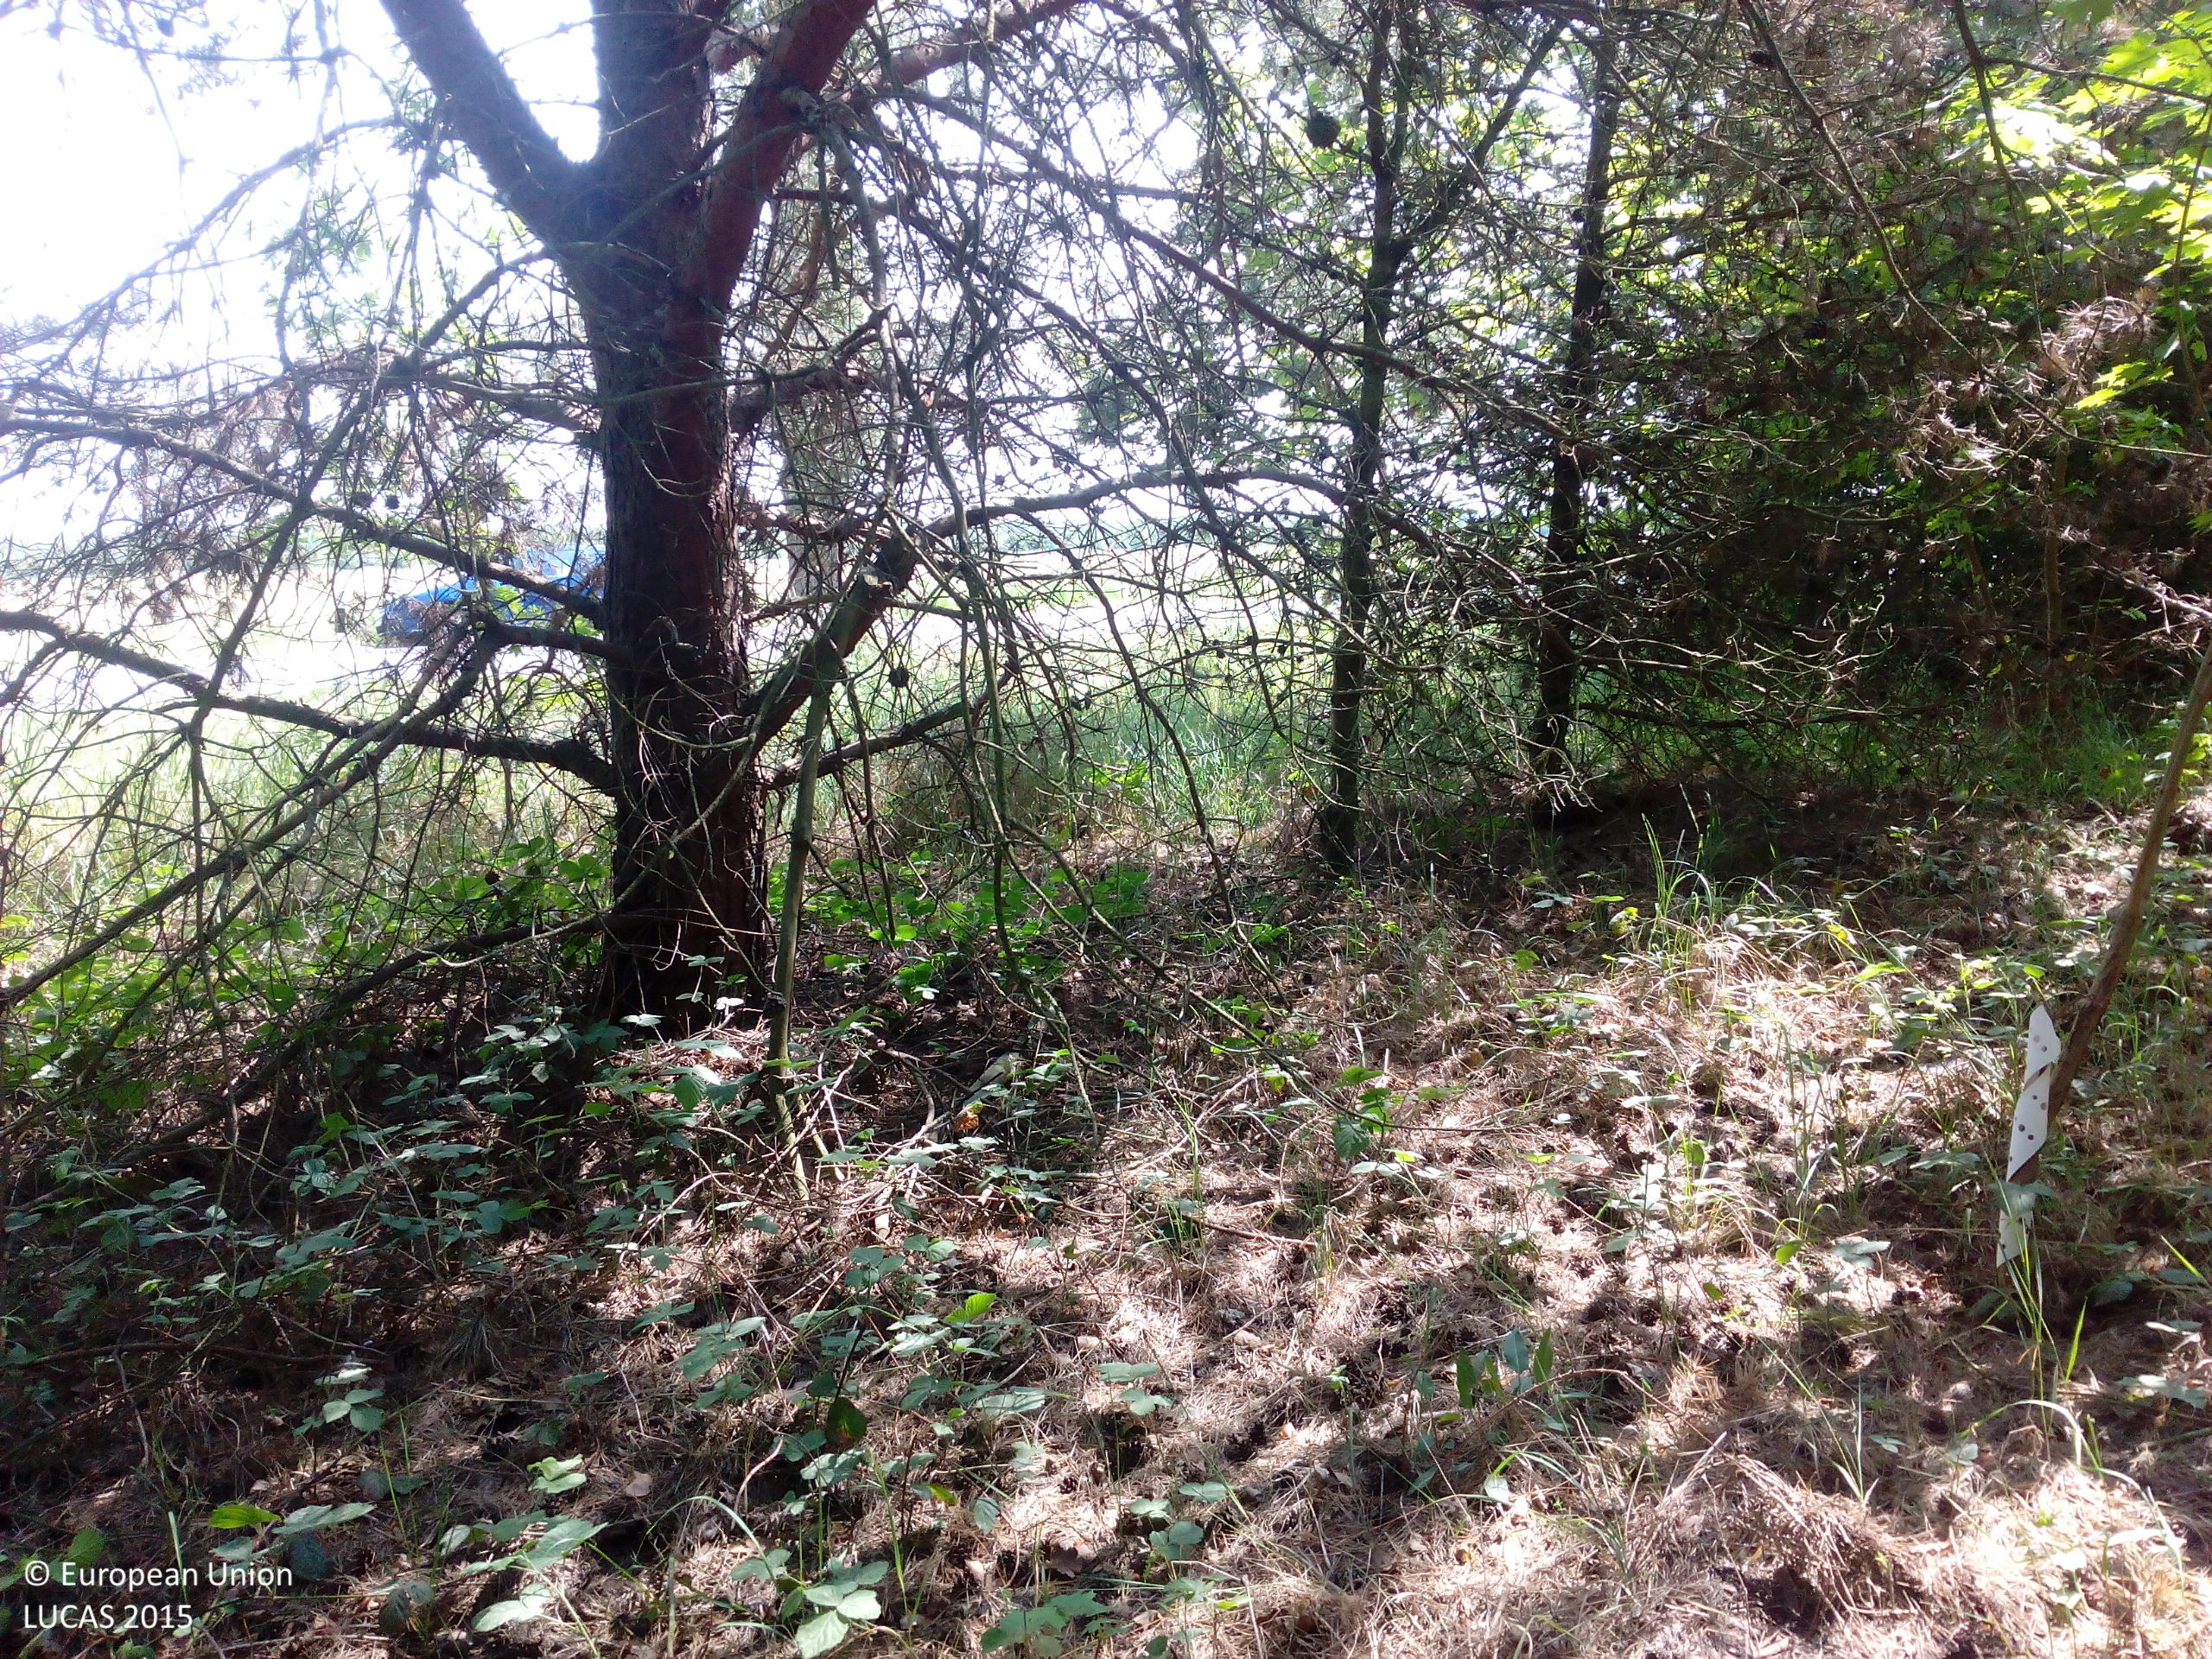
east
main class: Woodland
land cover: Pine dominated mixed woodland
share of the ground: > 75 %
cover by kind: coniferous forest trees 50 %, broadleaved forest trees 50 %
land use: Forestry
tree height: > 5 m
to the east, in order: Pine dominated mixed woodland; Grass margins; Paved roads, cycling and walking lanes; Lines of trees; Ditches and canals; Grass margins; Paved roads, cycling and walking lanes; Grass margins; Lines of trees; Grassland without tree/shrub cover
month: May
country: DE
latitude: 51.6343
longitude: 12.3836
